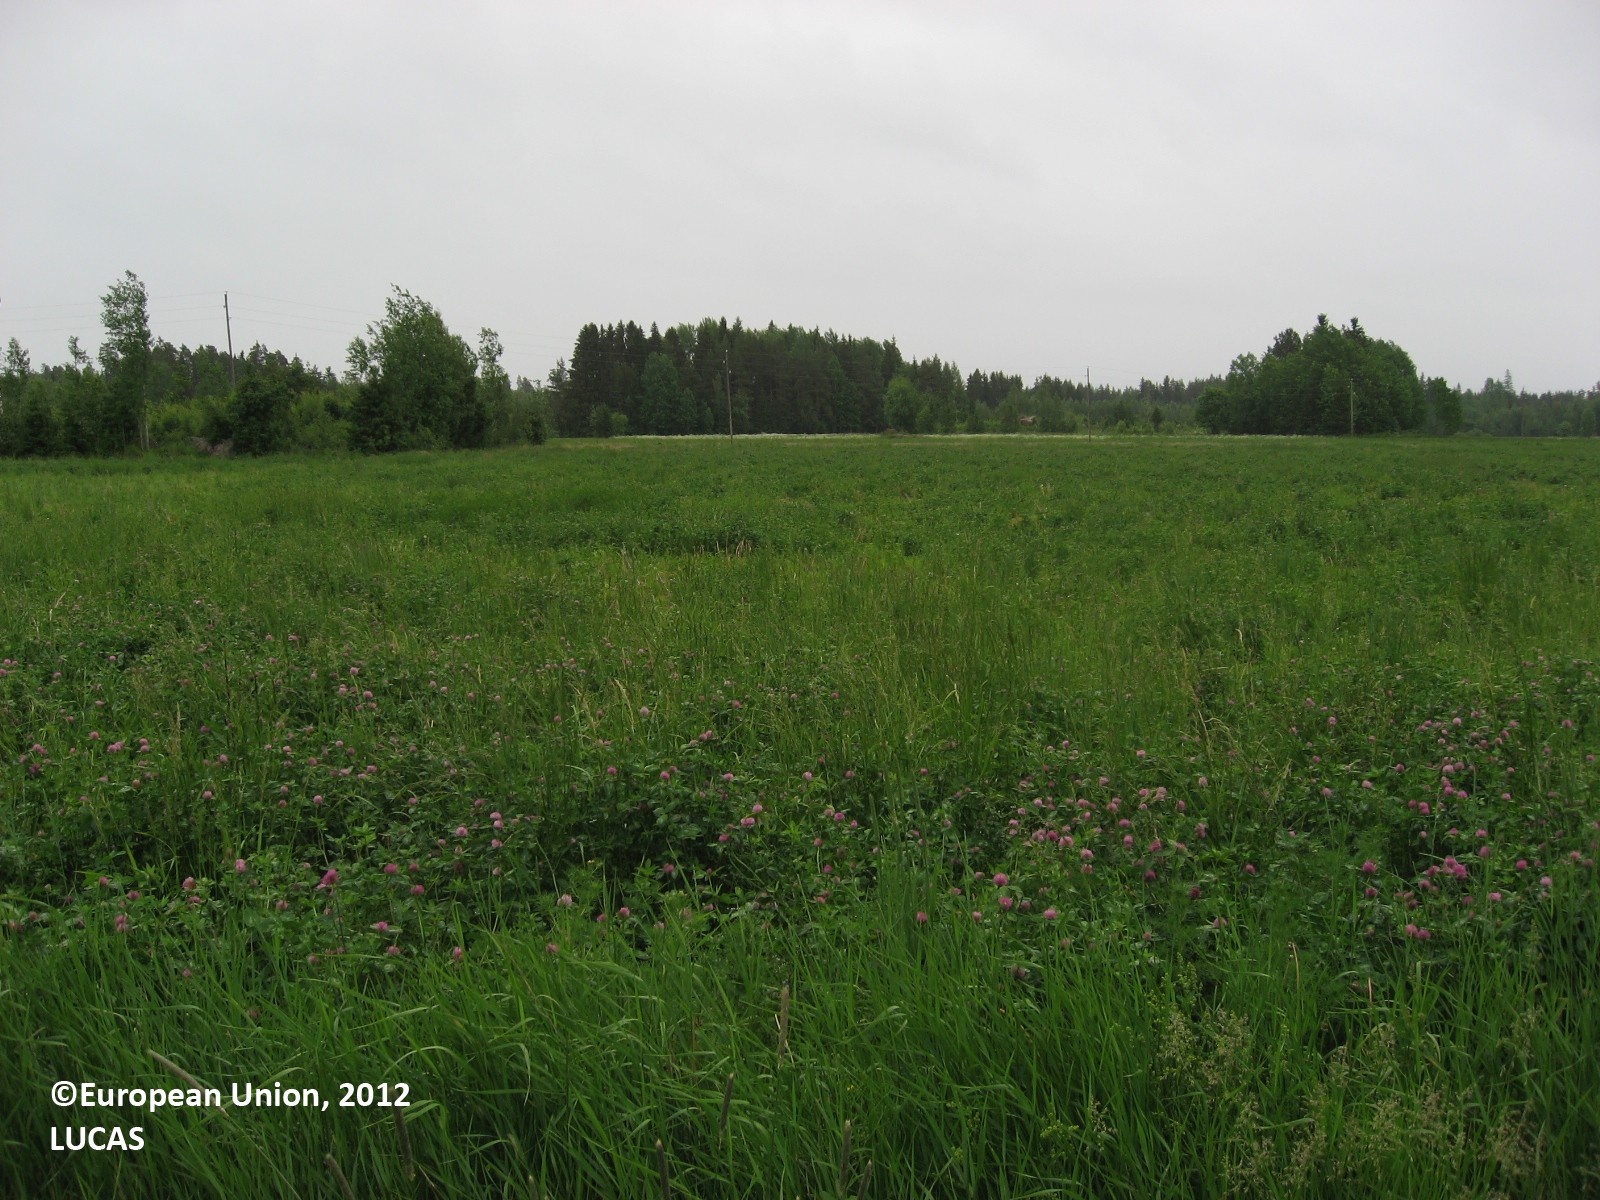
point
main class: Cropland
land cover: Clovers
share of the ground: > 75 %
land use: Agriculture (excluding fallow land and kitchen gardens)
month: June
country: FI
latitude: 60.5174
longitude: 26.2699
